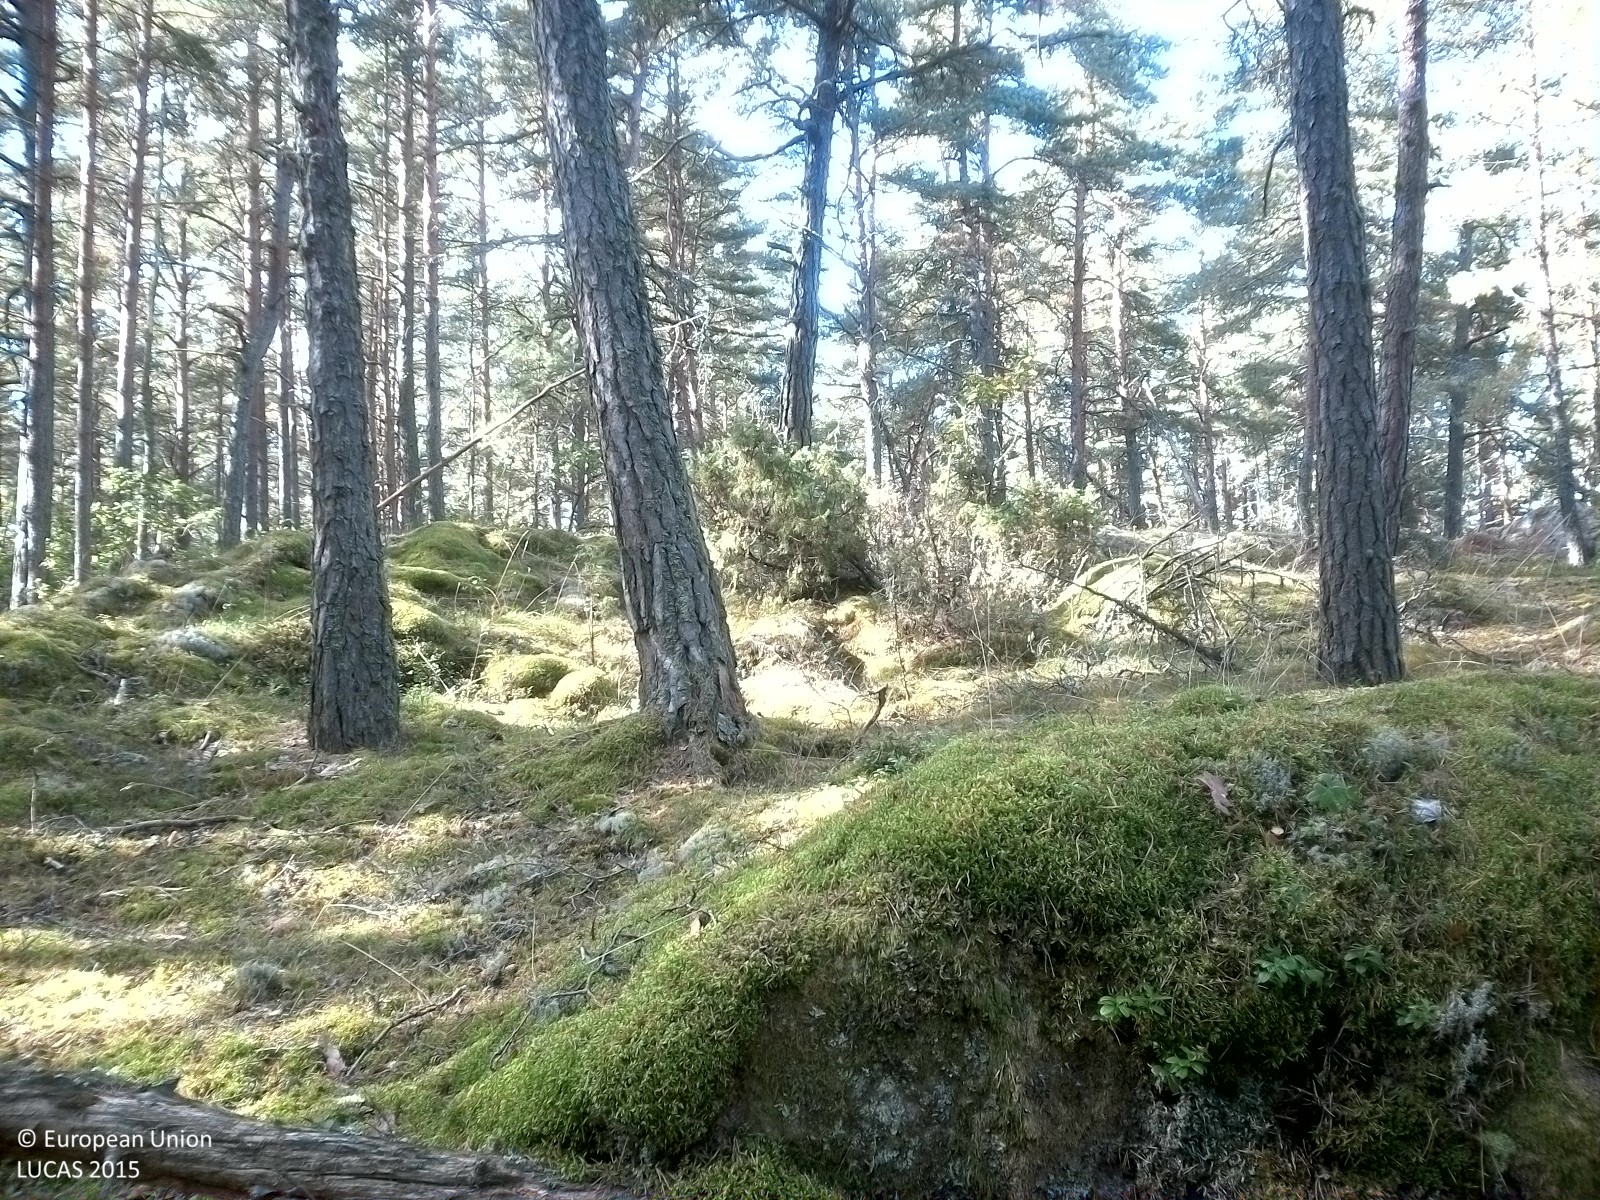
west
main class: Woodland
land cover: Pine dominated coniferous woodland
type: boreal forest
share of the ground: 25 - 50 %
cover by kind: herbaceous plants 55 %, coniferous forest trees 25 %, lichens and mosses 15 %, broadleaved forest trees 5 %
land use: Forestry
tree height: > 5 m
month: September
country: SE
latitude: 58.5232
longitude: 16.2971
